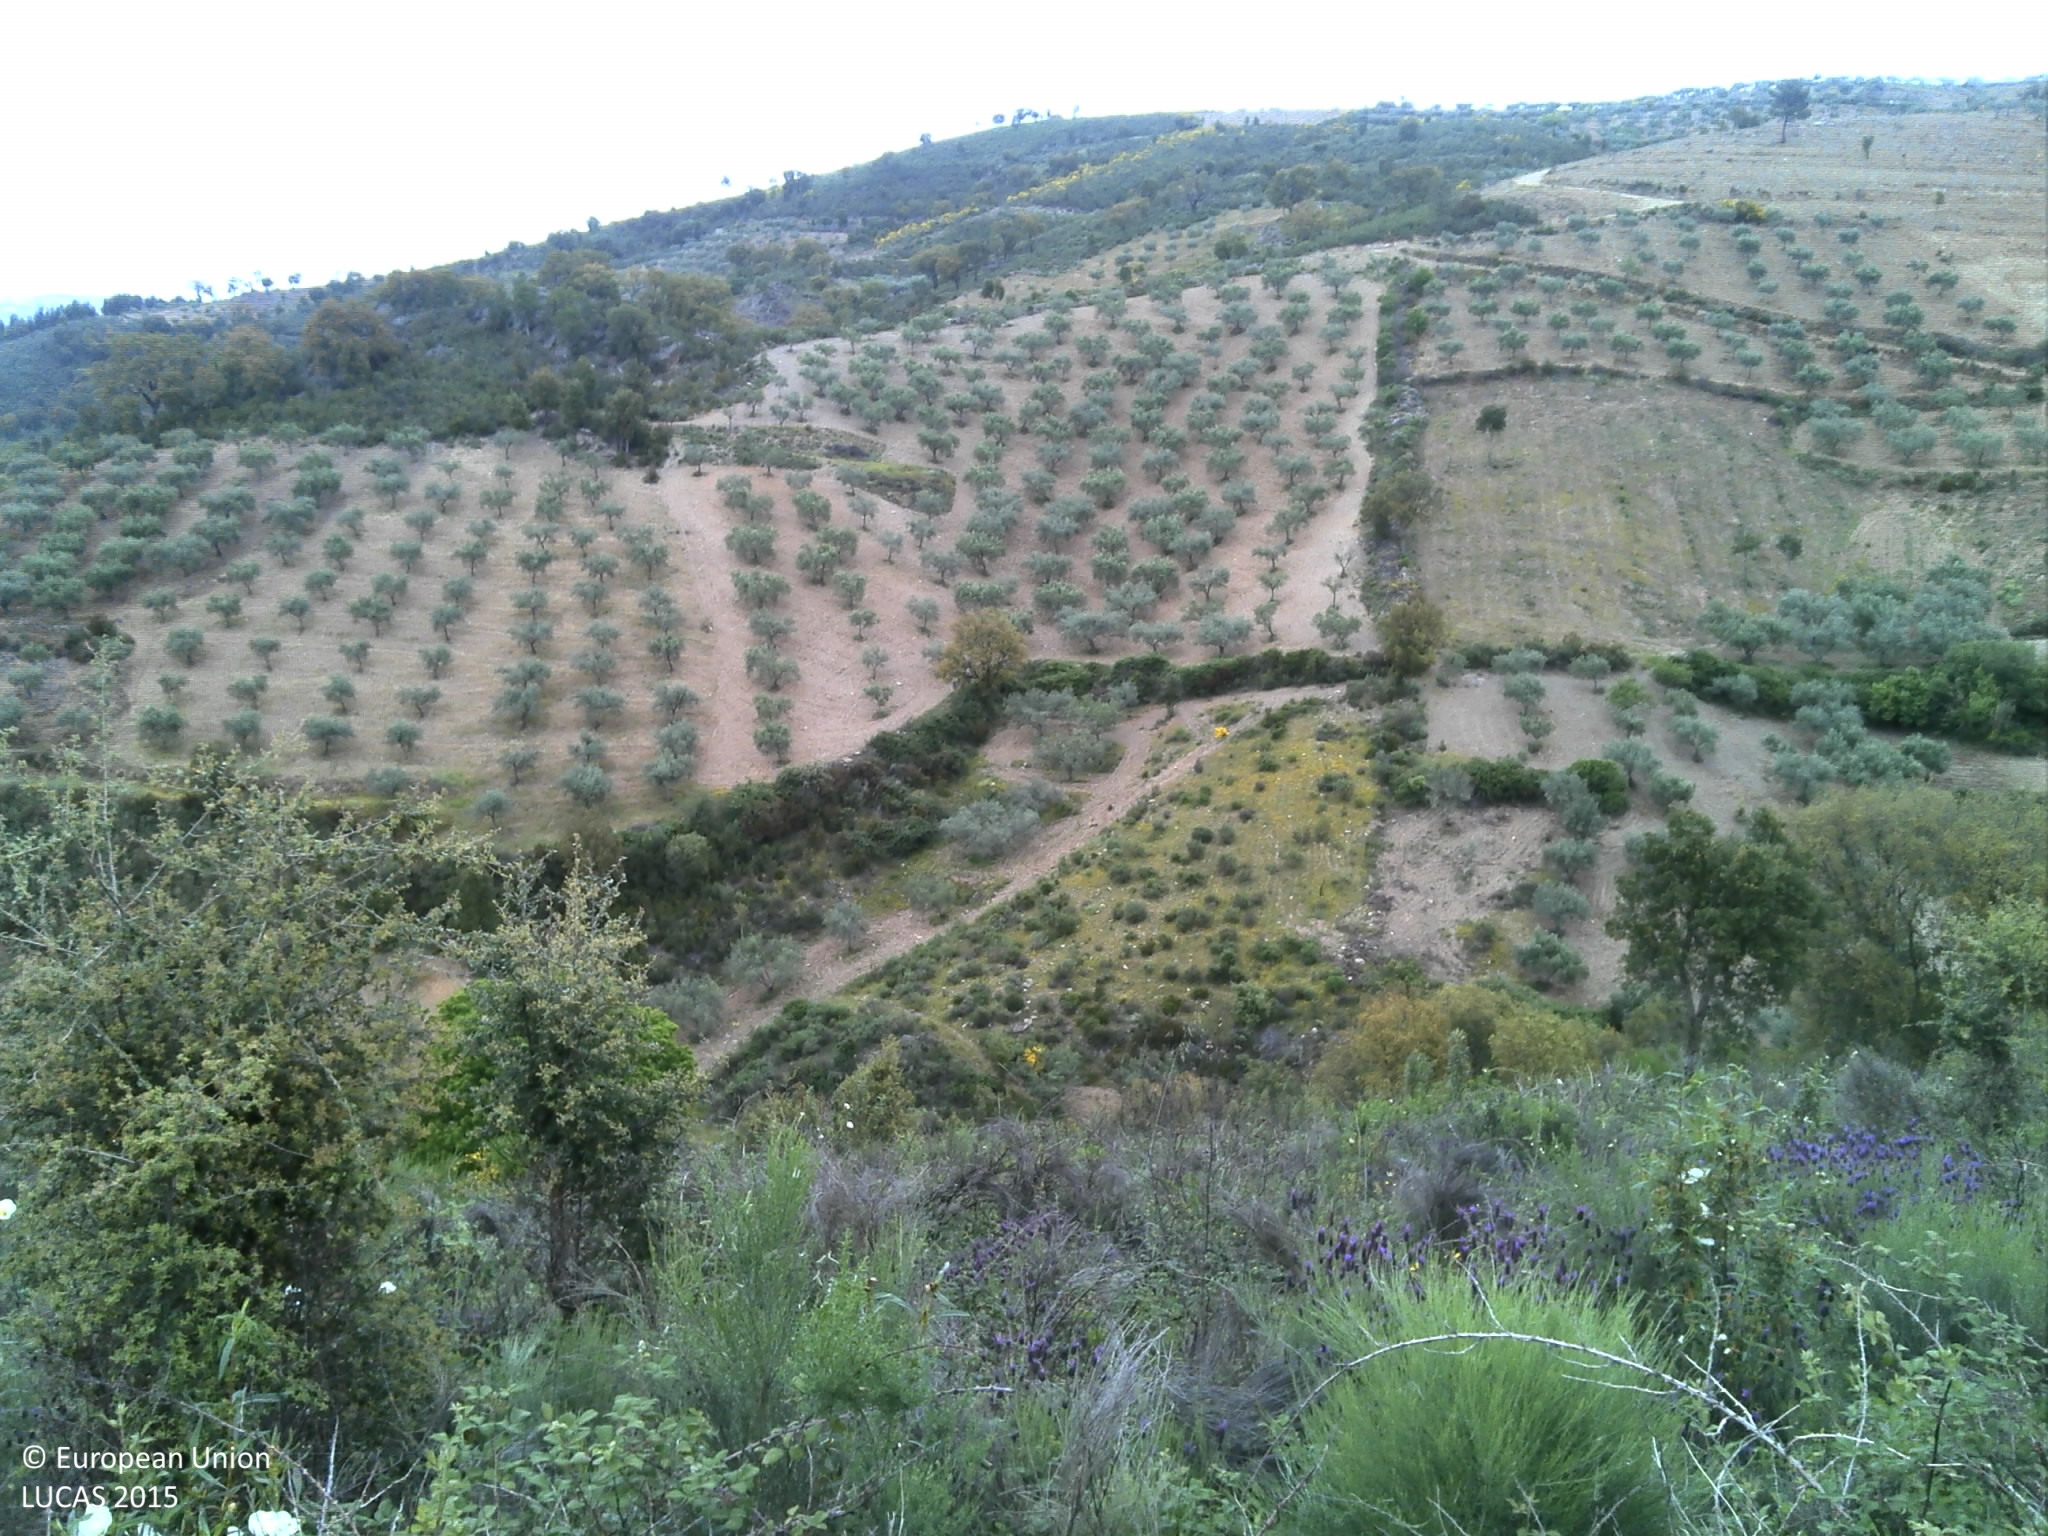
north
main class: Shrubland
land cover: Shrubland with sparse tree cover
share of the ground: 50 - 75 %
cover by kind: shrubs 75 %, herbaceous plants 15 %, broadleaved forest trees 5 %, unconsolidated bare surface 5 %
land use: Semi-natural and natural areas not in use
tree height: > 5 m
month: May
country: PT
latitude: 41.6232
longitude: -7.0283
